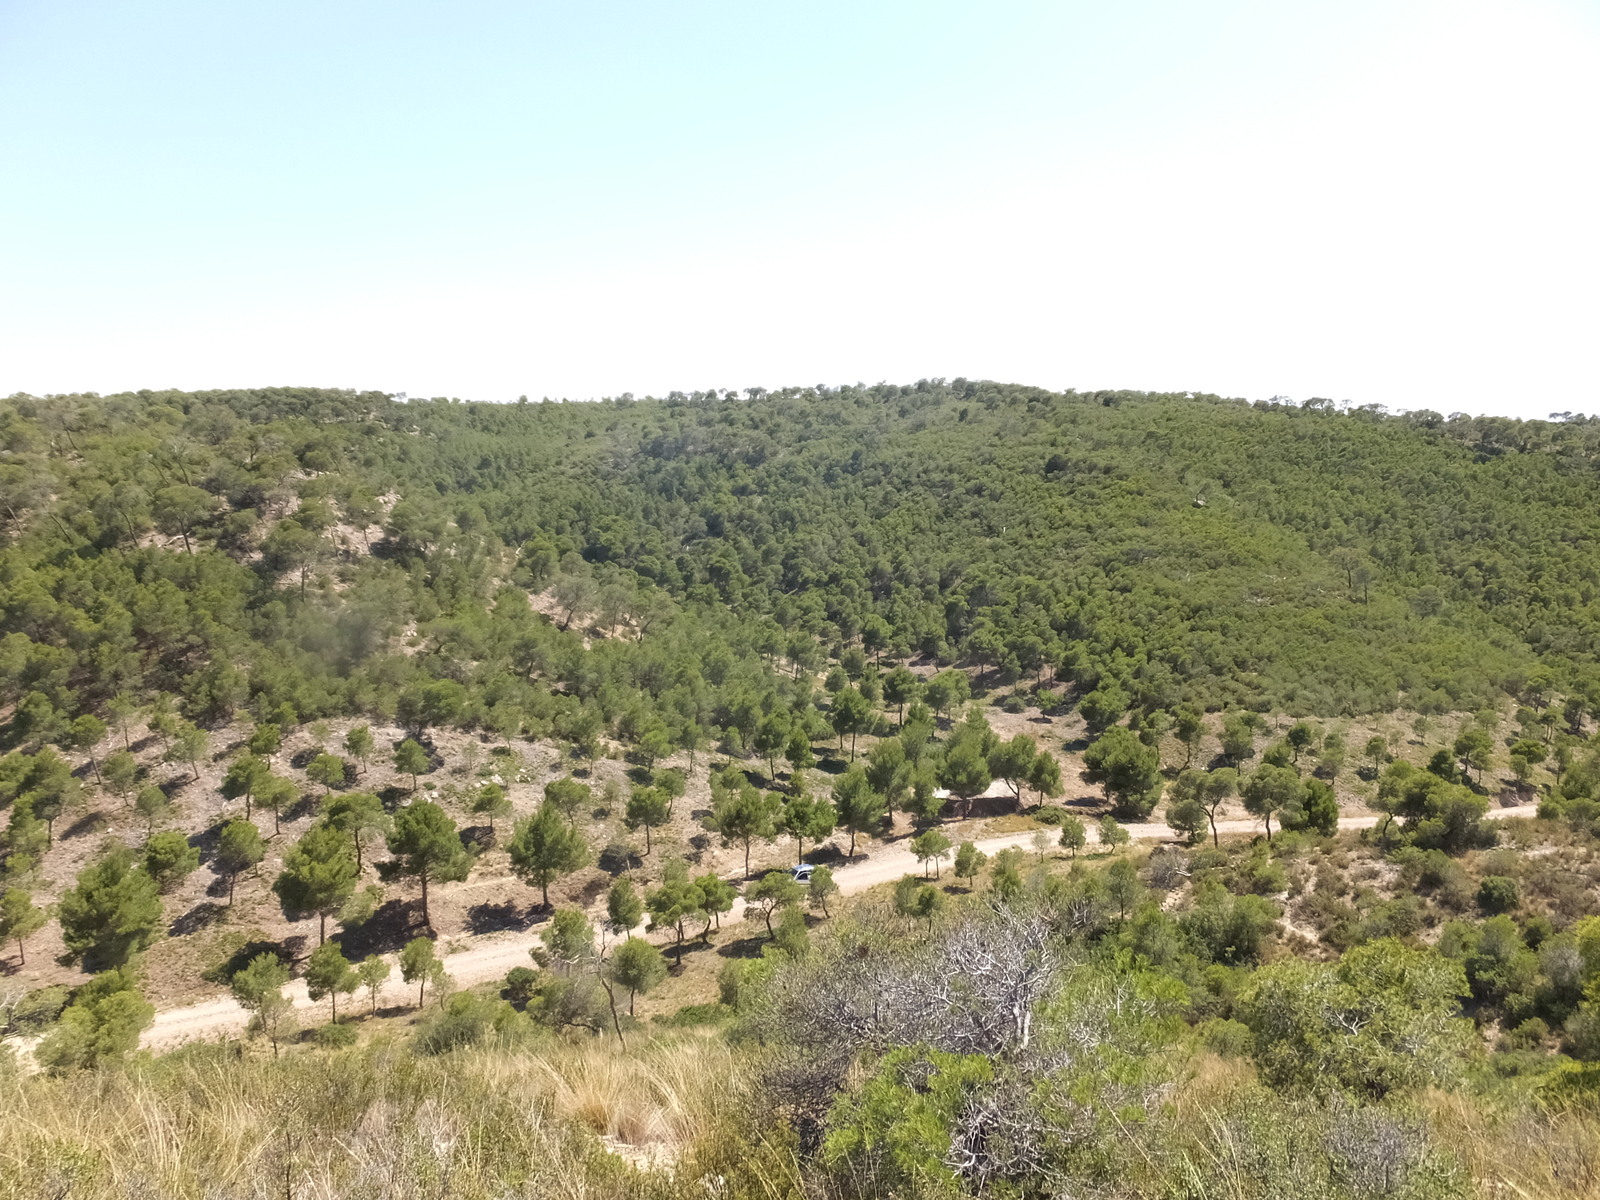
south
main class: Woodland
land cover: Pine dominated mixed woodland
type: coniferous forest of the mediterranean region
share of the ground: 25 - 50 %
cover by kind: shrubs 35 %, coniferous forest trees 25 %, herbaceous plants 25 %, broadleaved forest trees 15 %
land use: Forestry
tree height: > 5 m
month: June
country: ES
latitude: 41.3509
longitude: -0.0654
